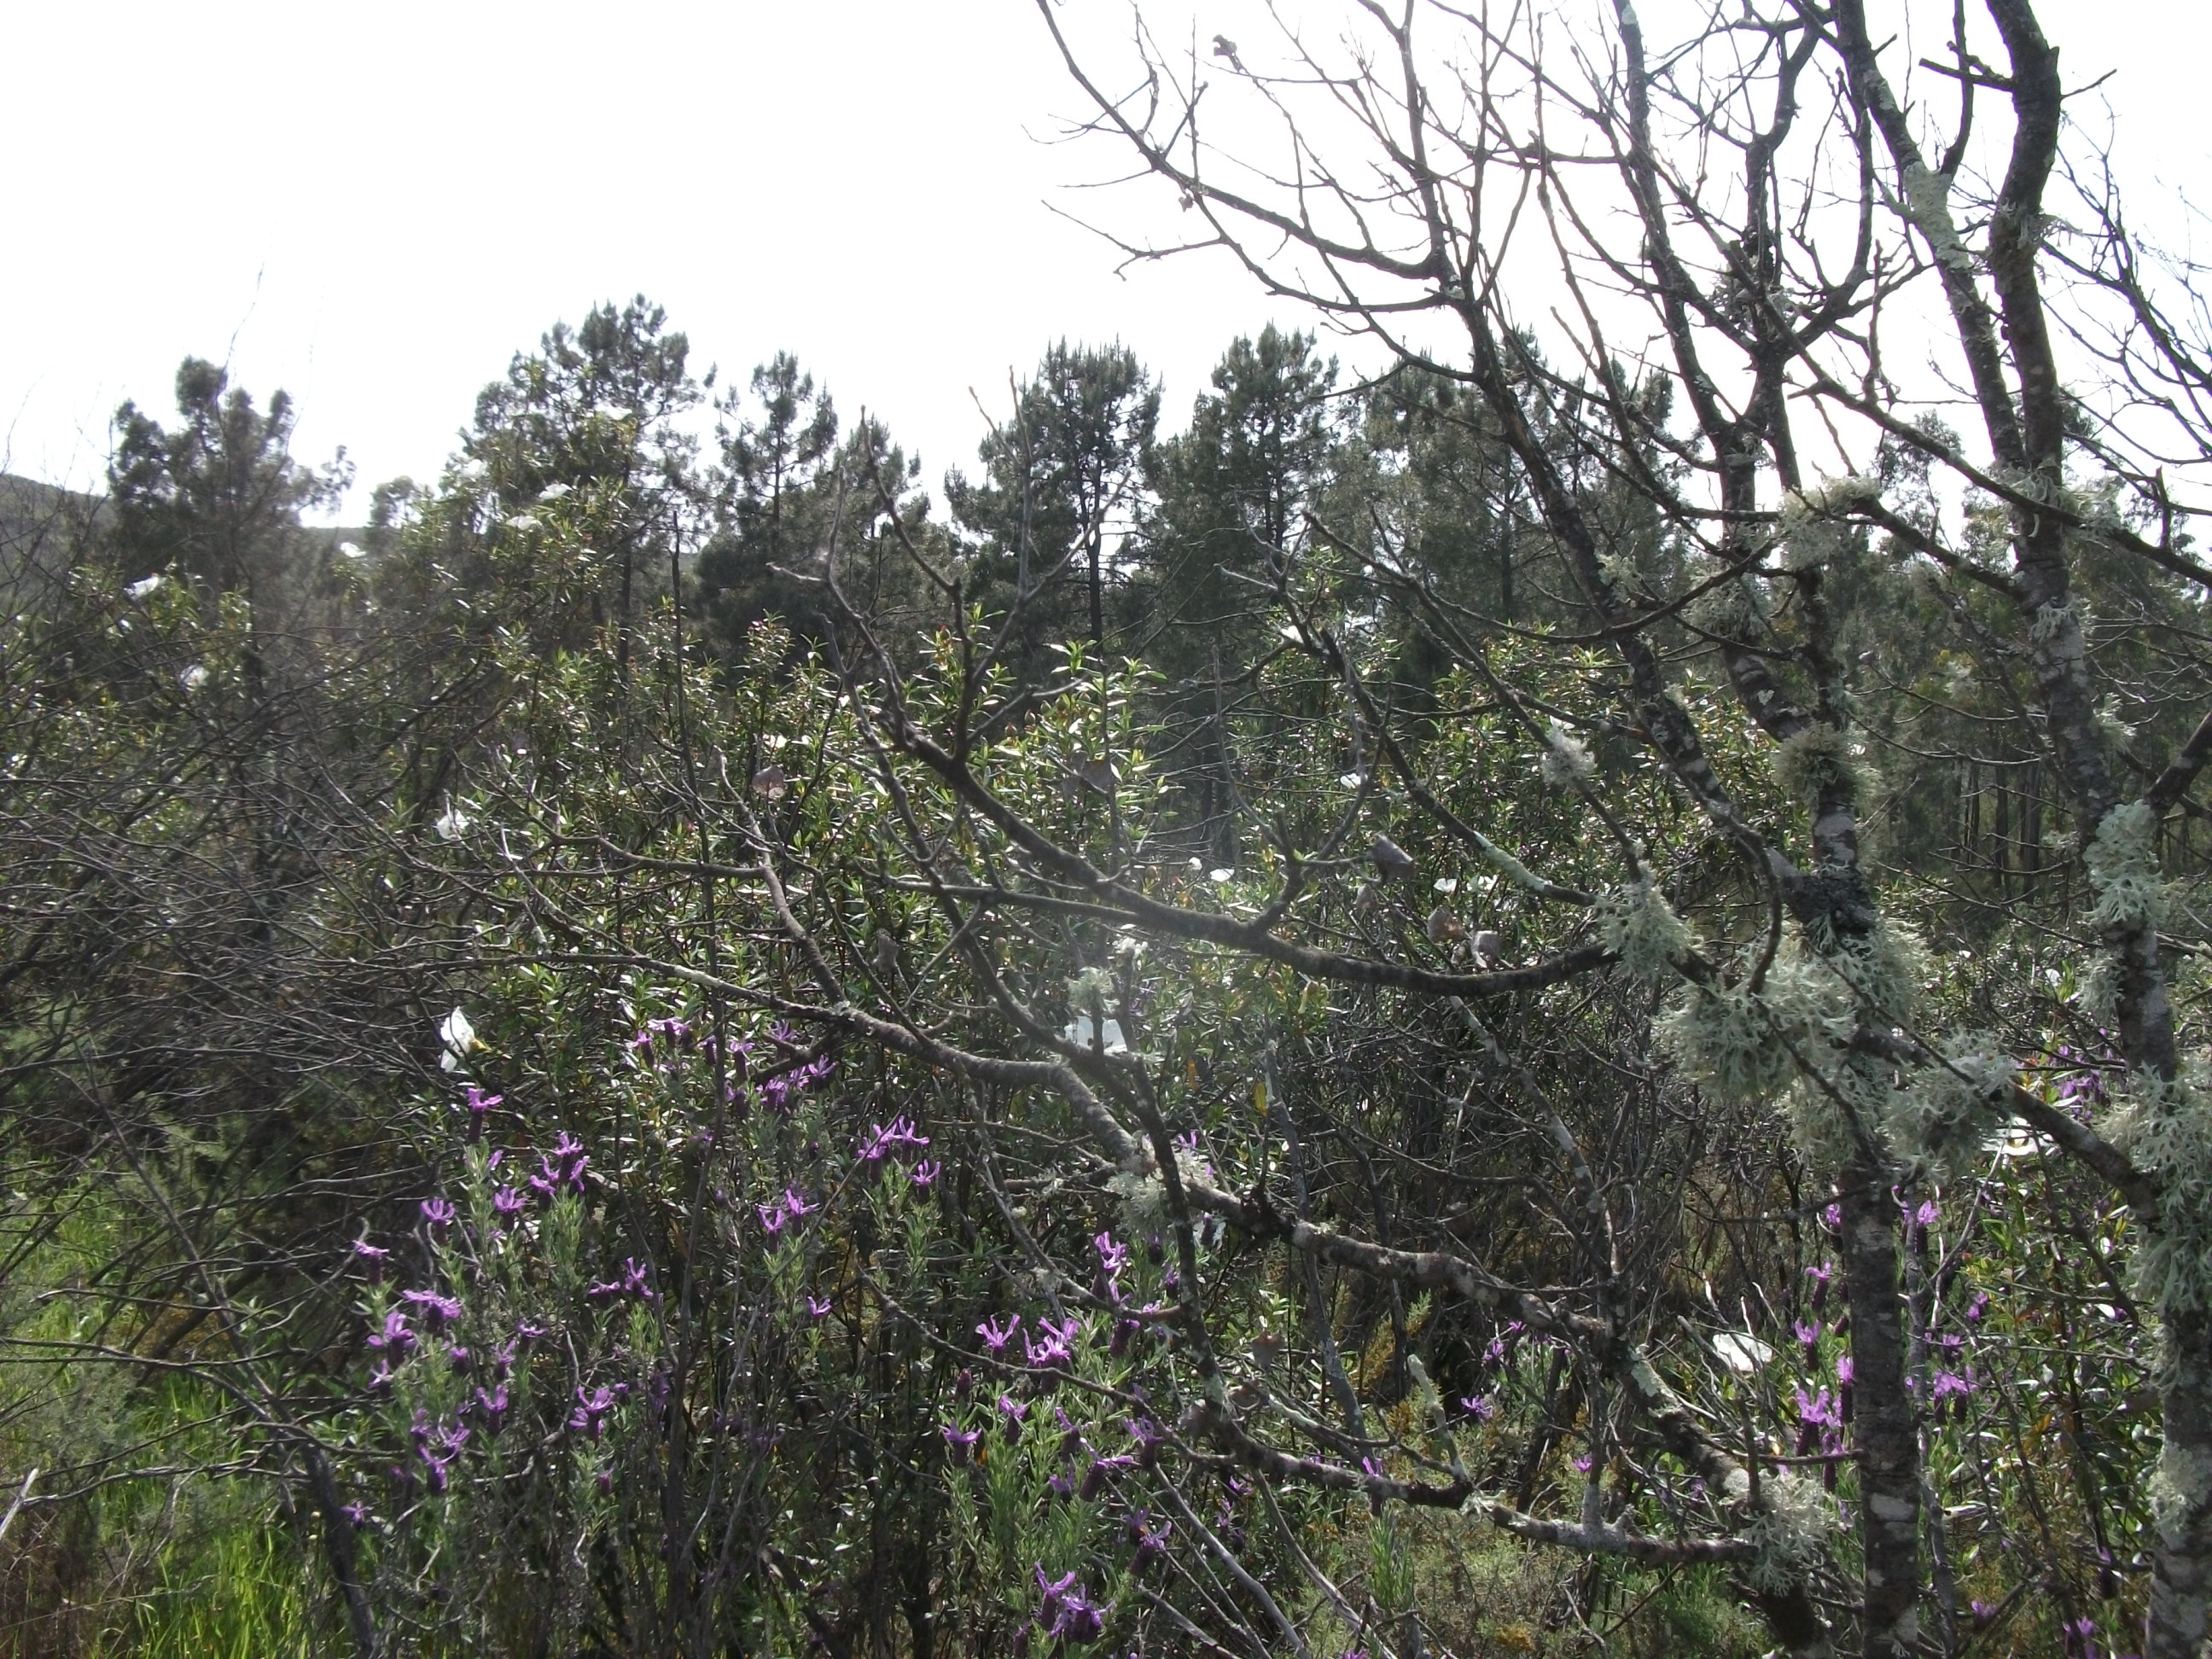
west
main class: Shrubland
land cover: Shrubland without tree cover
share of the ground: > 75 %
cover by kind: shrubs 90 %, herbaceous plants 10 %
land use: Semi-natural and natural areas not in use
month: April
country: ES
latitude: 37.7696
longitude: -6.7208
